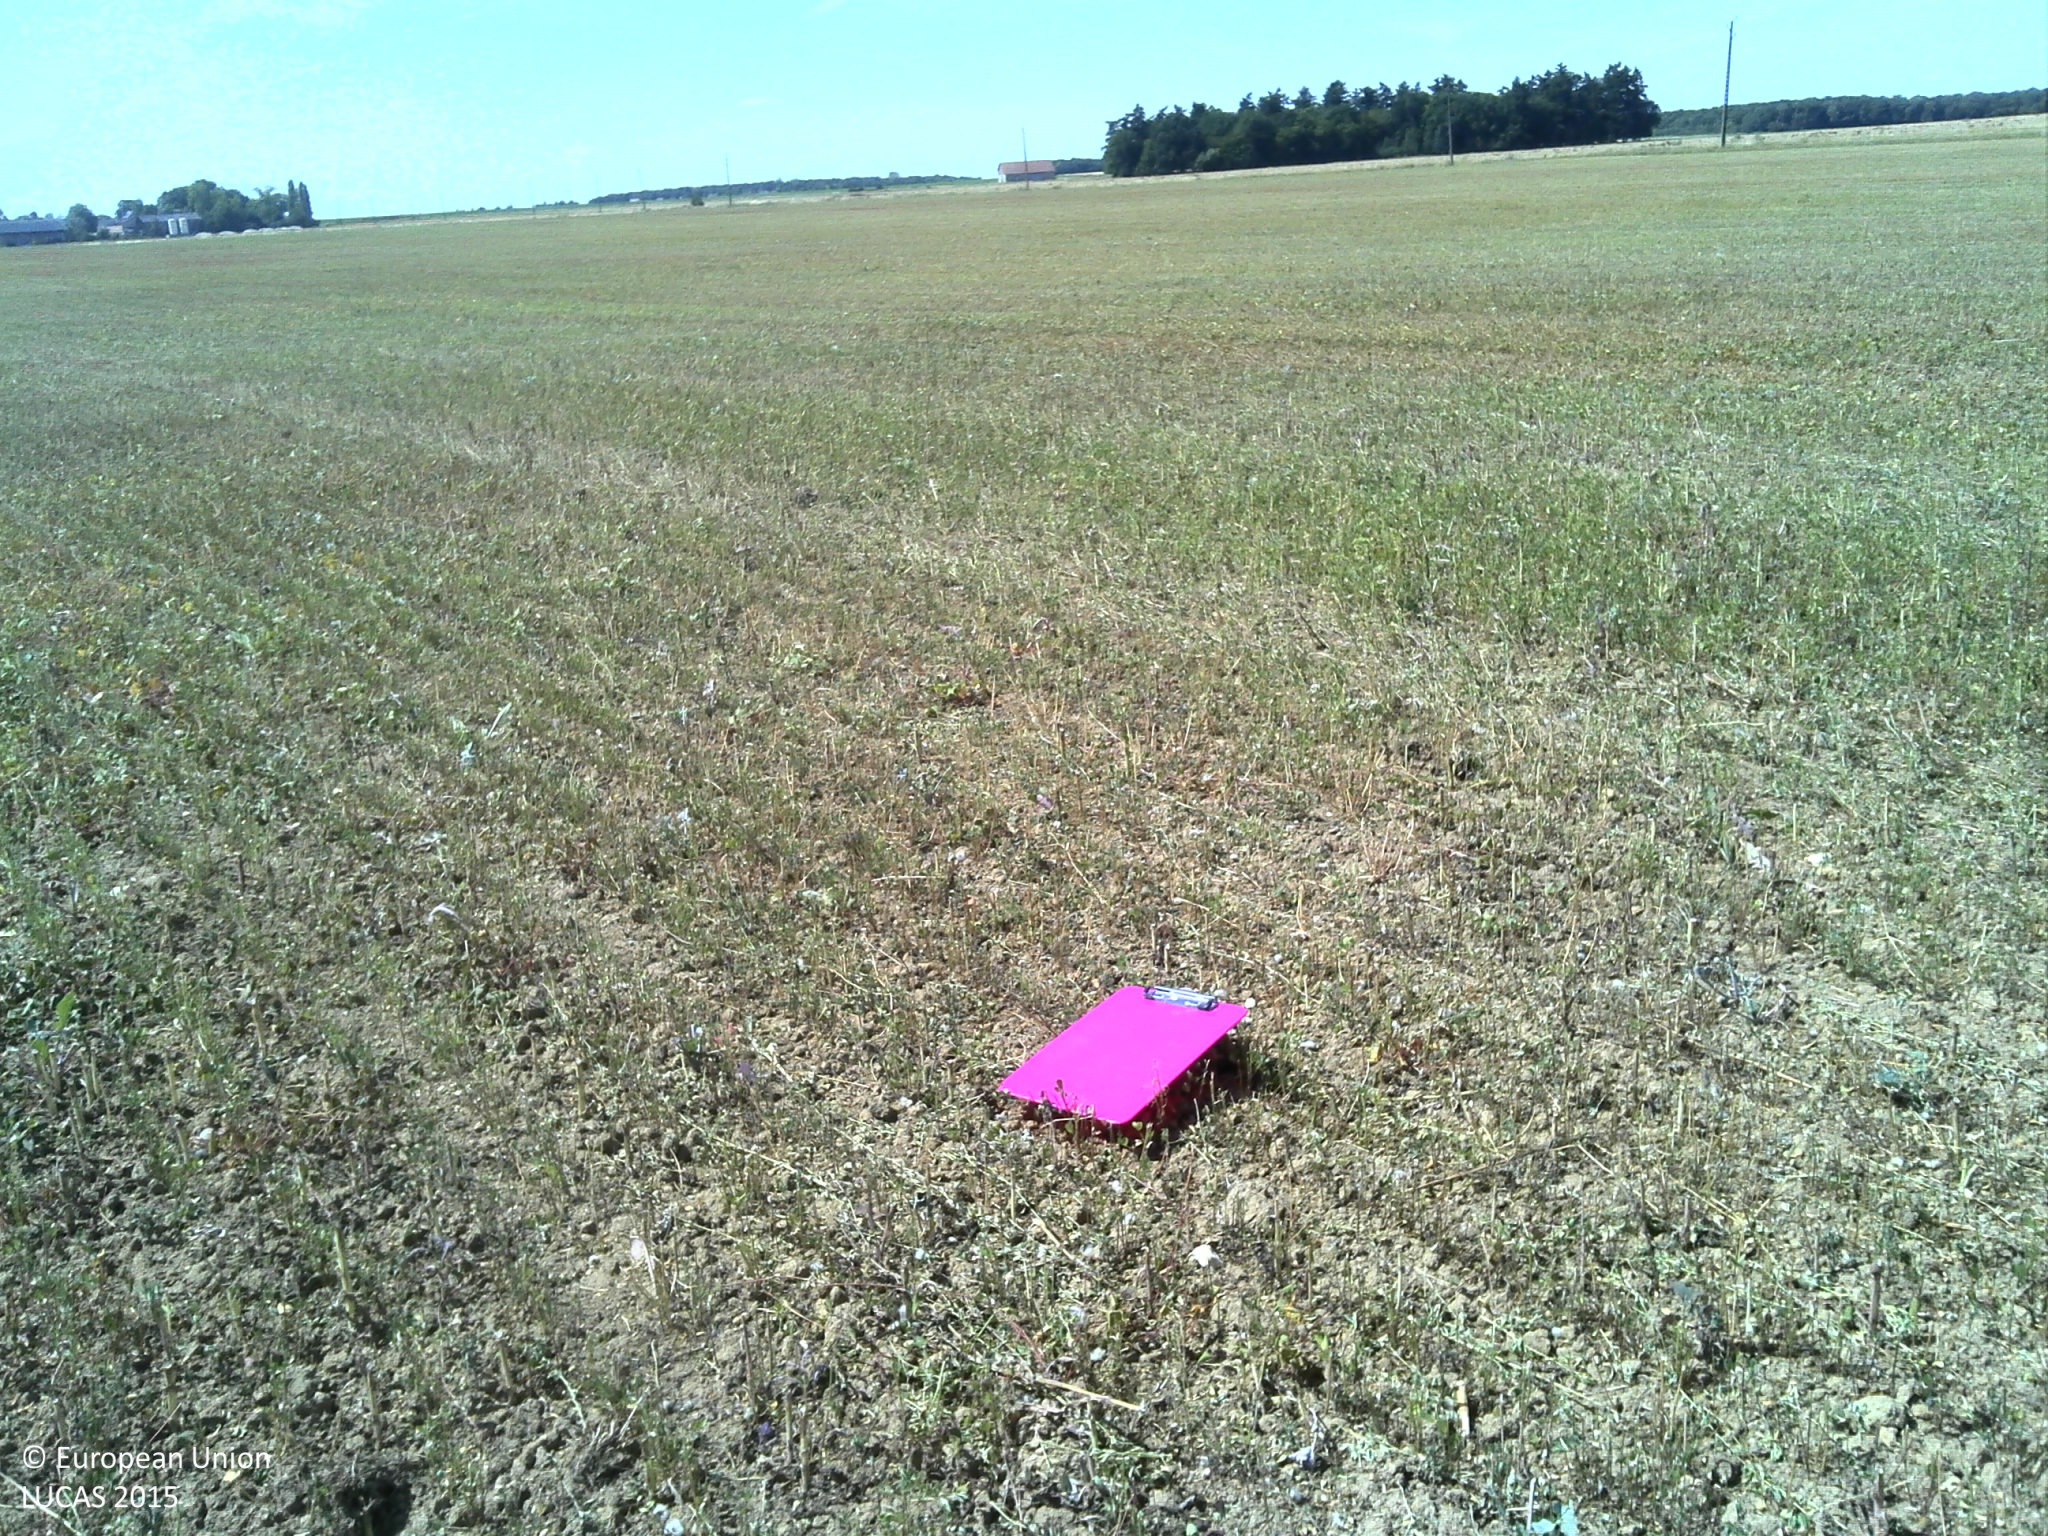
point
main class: Cropland
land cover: Temporary grasslands
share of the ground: > 75 %
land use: Agriculture (excluding fallow land and kitchen gardens)
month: July
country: FR
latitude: 48.5558
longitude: 1.8699
